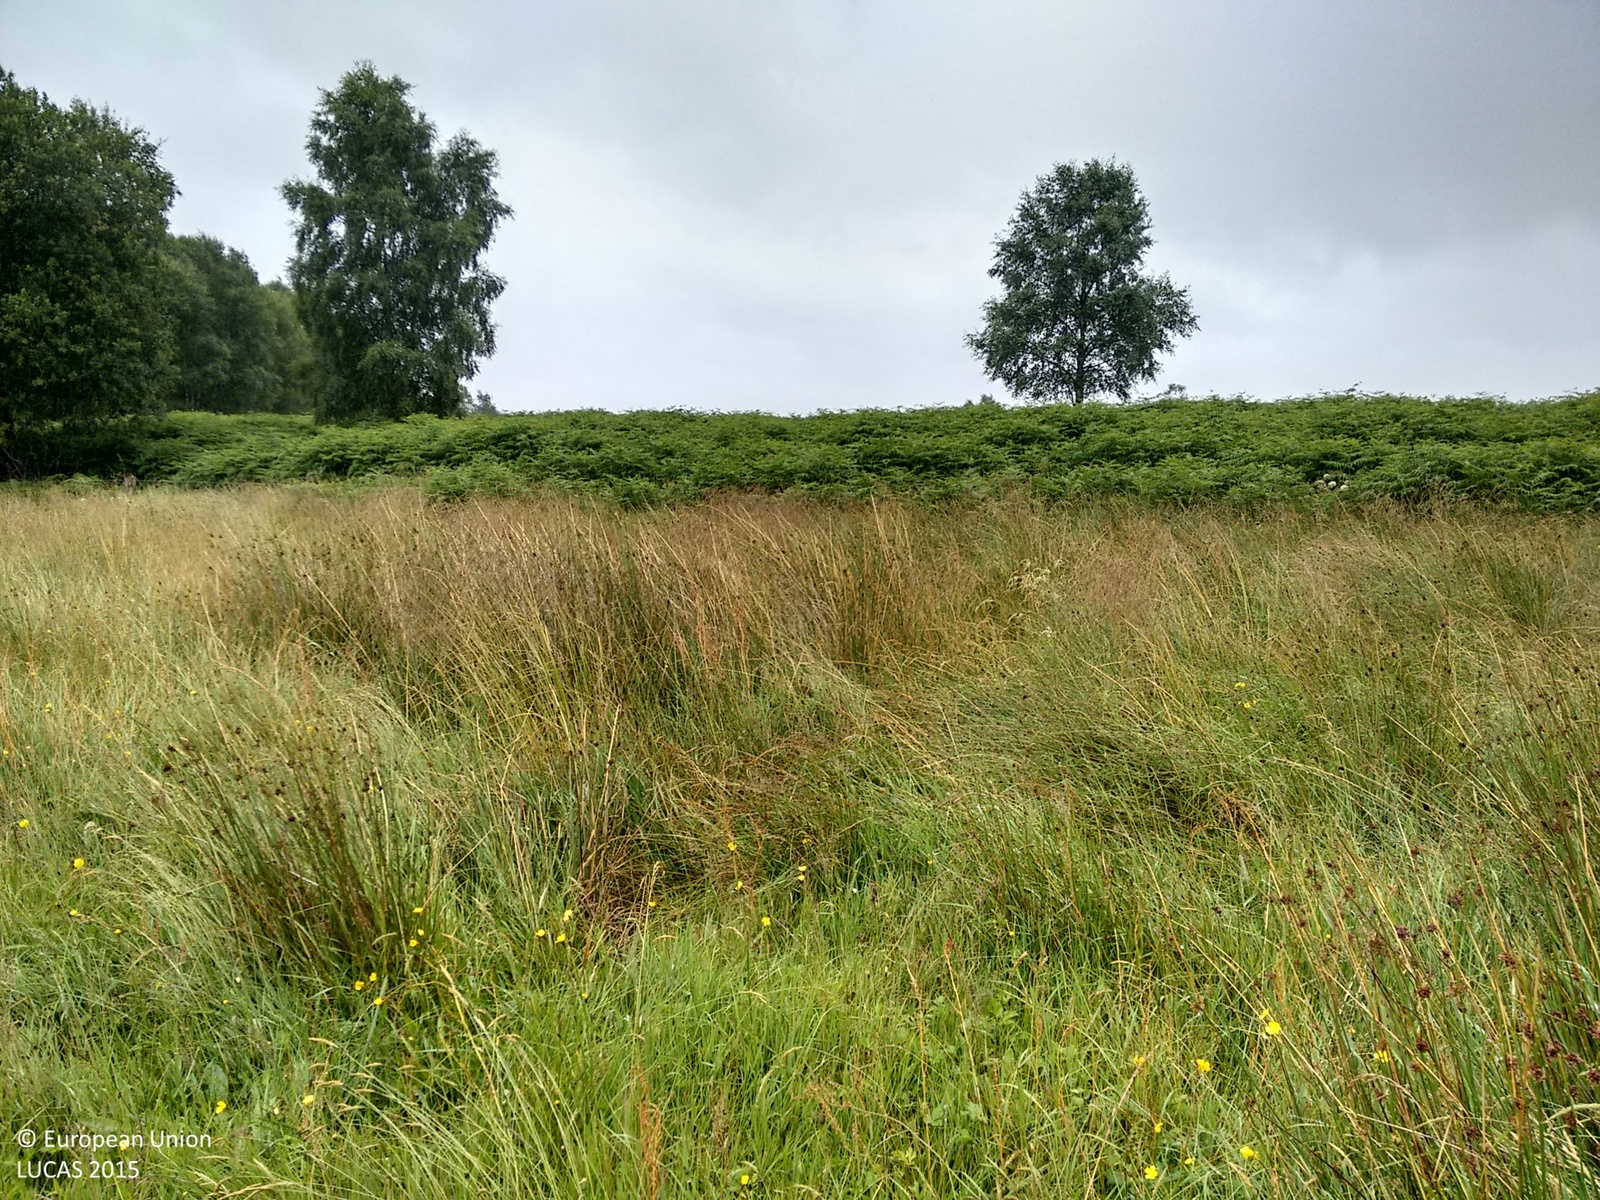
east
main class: Grassland
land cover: Grassland without tree/shrub cover
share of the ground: > 75 %
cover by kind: herbaceous plants 100 %
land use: Agriculture (excluding fallow land and kitchen gardens)
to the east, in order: Grassland without tree/shrub cover; Fences; Shrubland with sparse tree cover; Peatbogs; Rivers and streams; Peatbogs
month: July
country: IE
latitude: 53.8103
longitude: -7.8622
